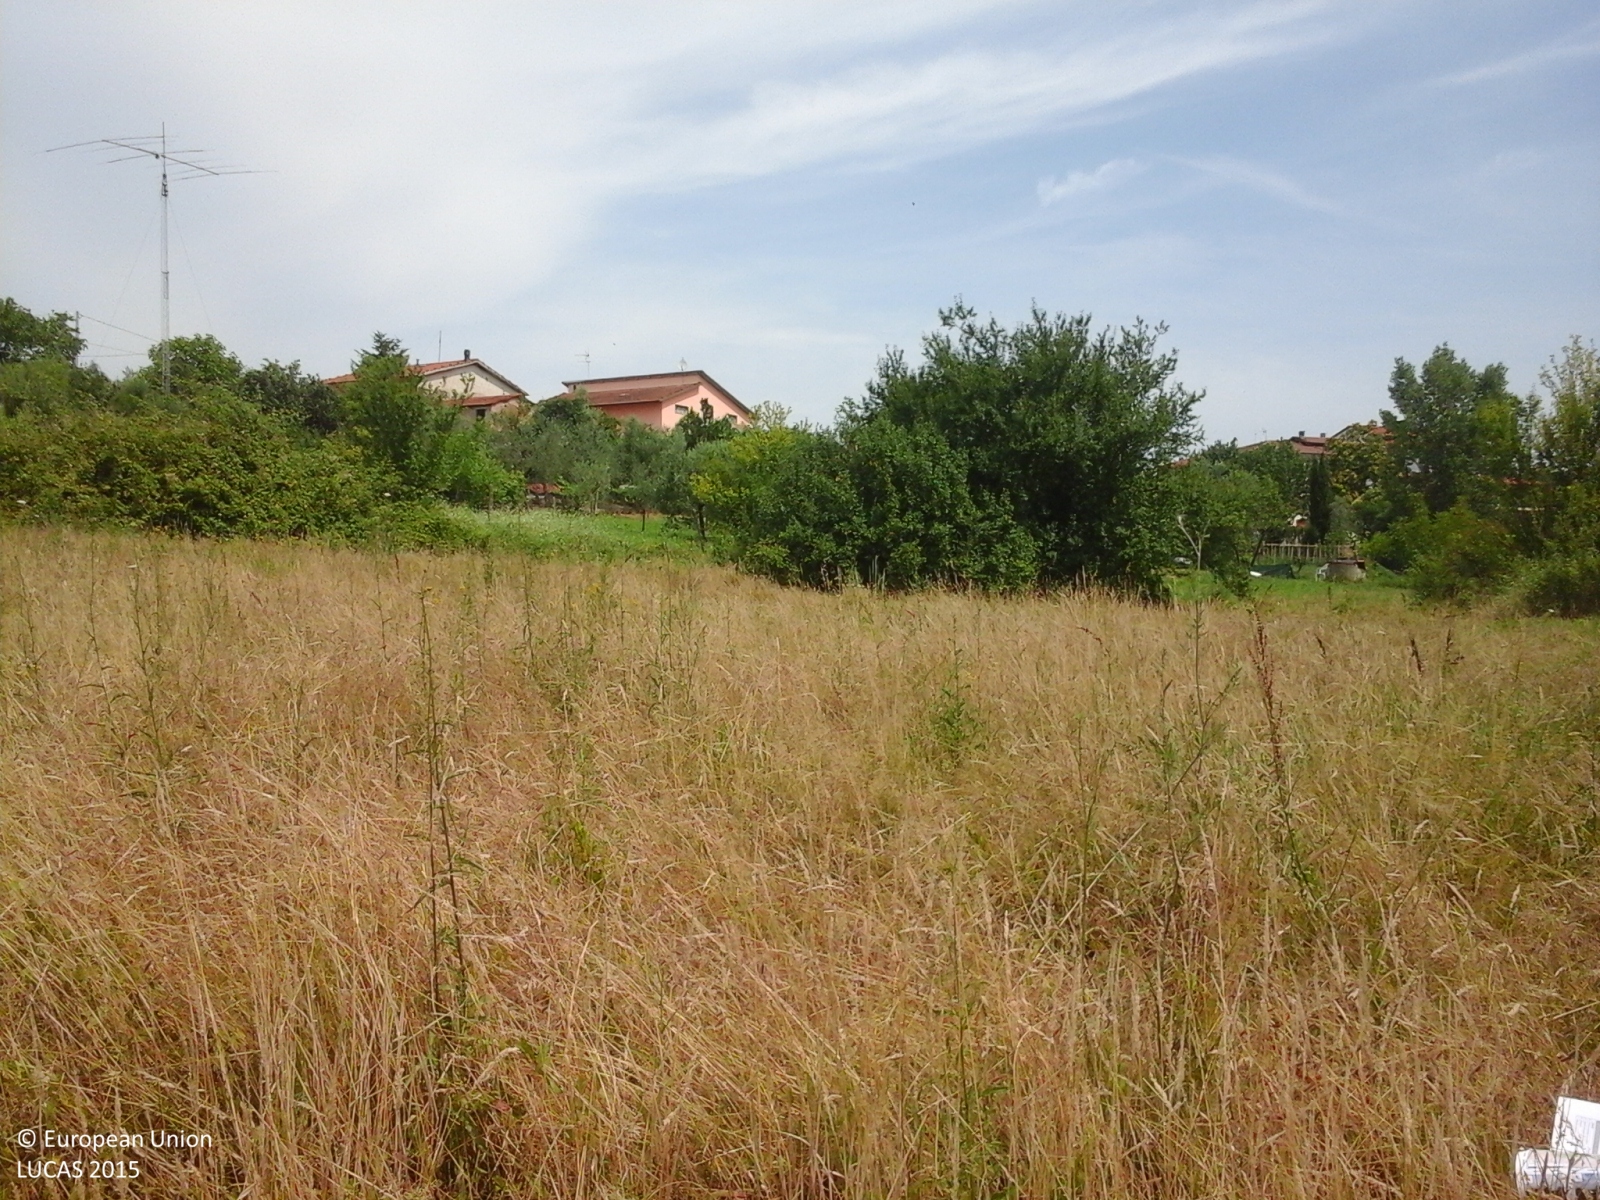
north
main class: Grassland
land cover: Grassland without tree/shrub cover
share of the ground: > 75 %
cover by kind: herbaceous plants 100 %
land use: Agriculture (excluding fallow land and kitchen gardens)
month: June
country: IT
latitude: 43.8056
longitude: 10.8803
